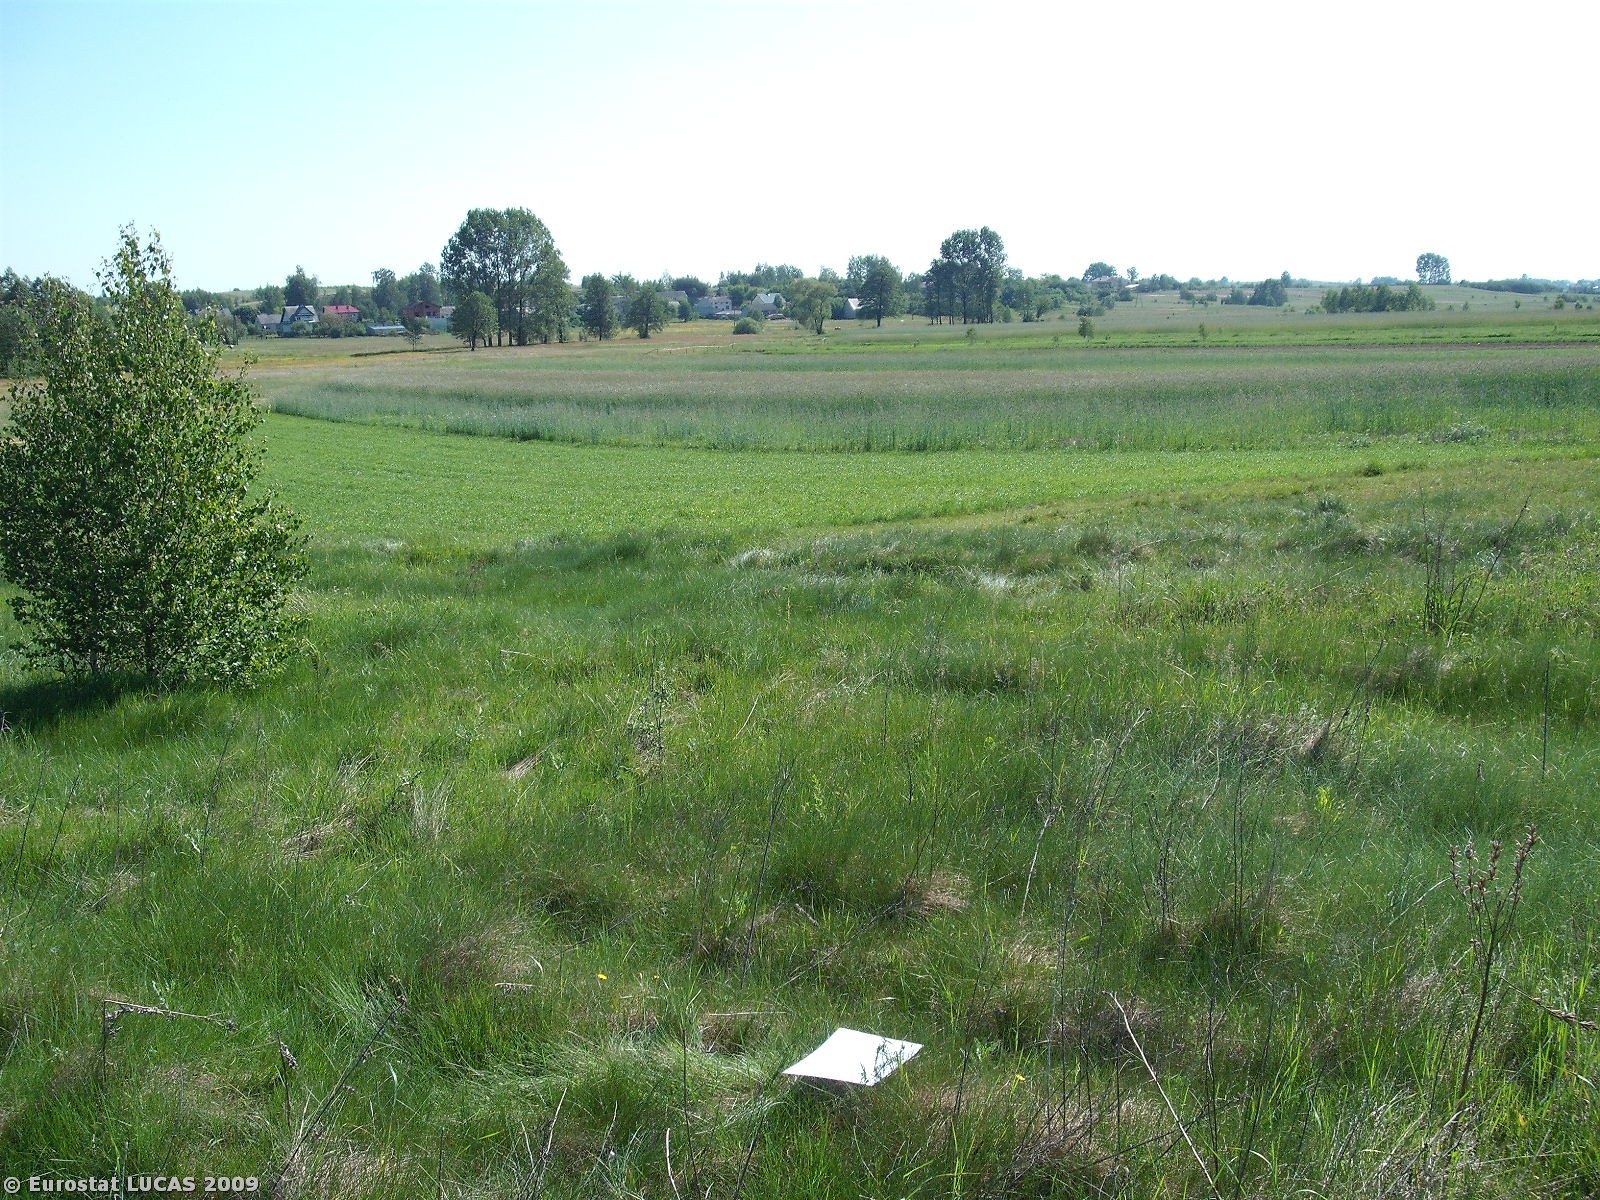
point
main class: Grassland
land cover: Grassland without tree/shrub cover
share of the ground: > 75 %
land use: Unused
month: May
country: PL
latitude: 51.1966
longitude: 20.9628
